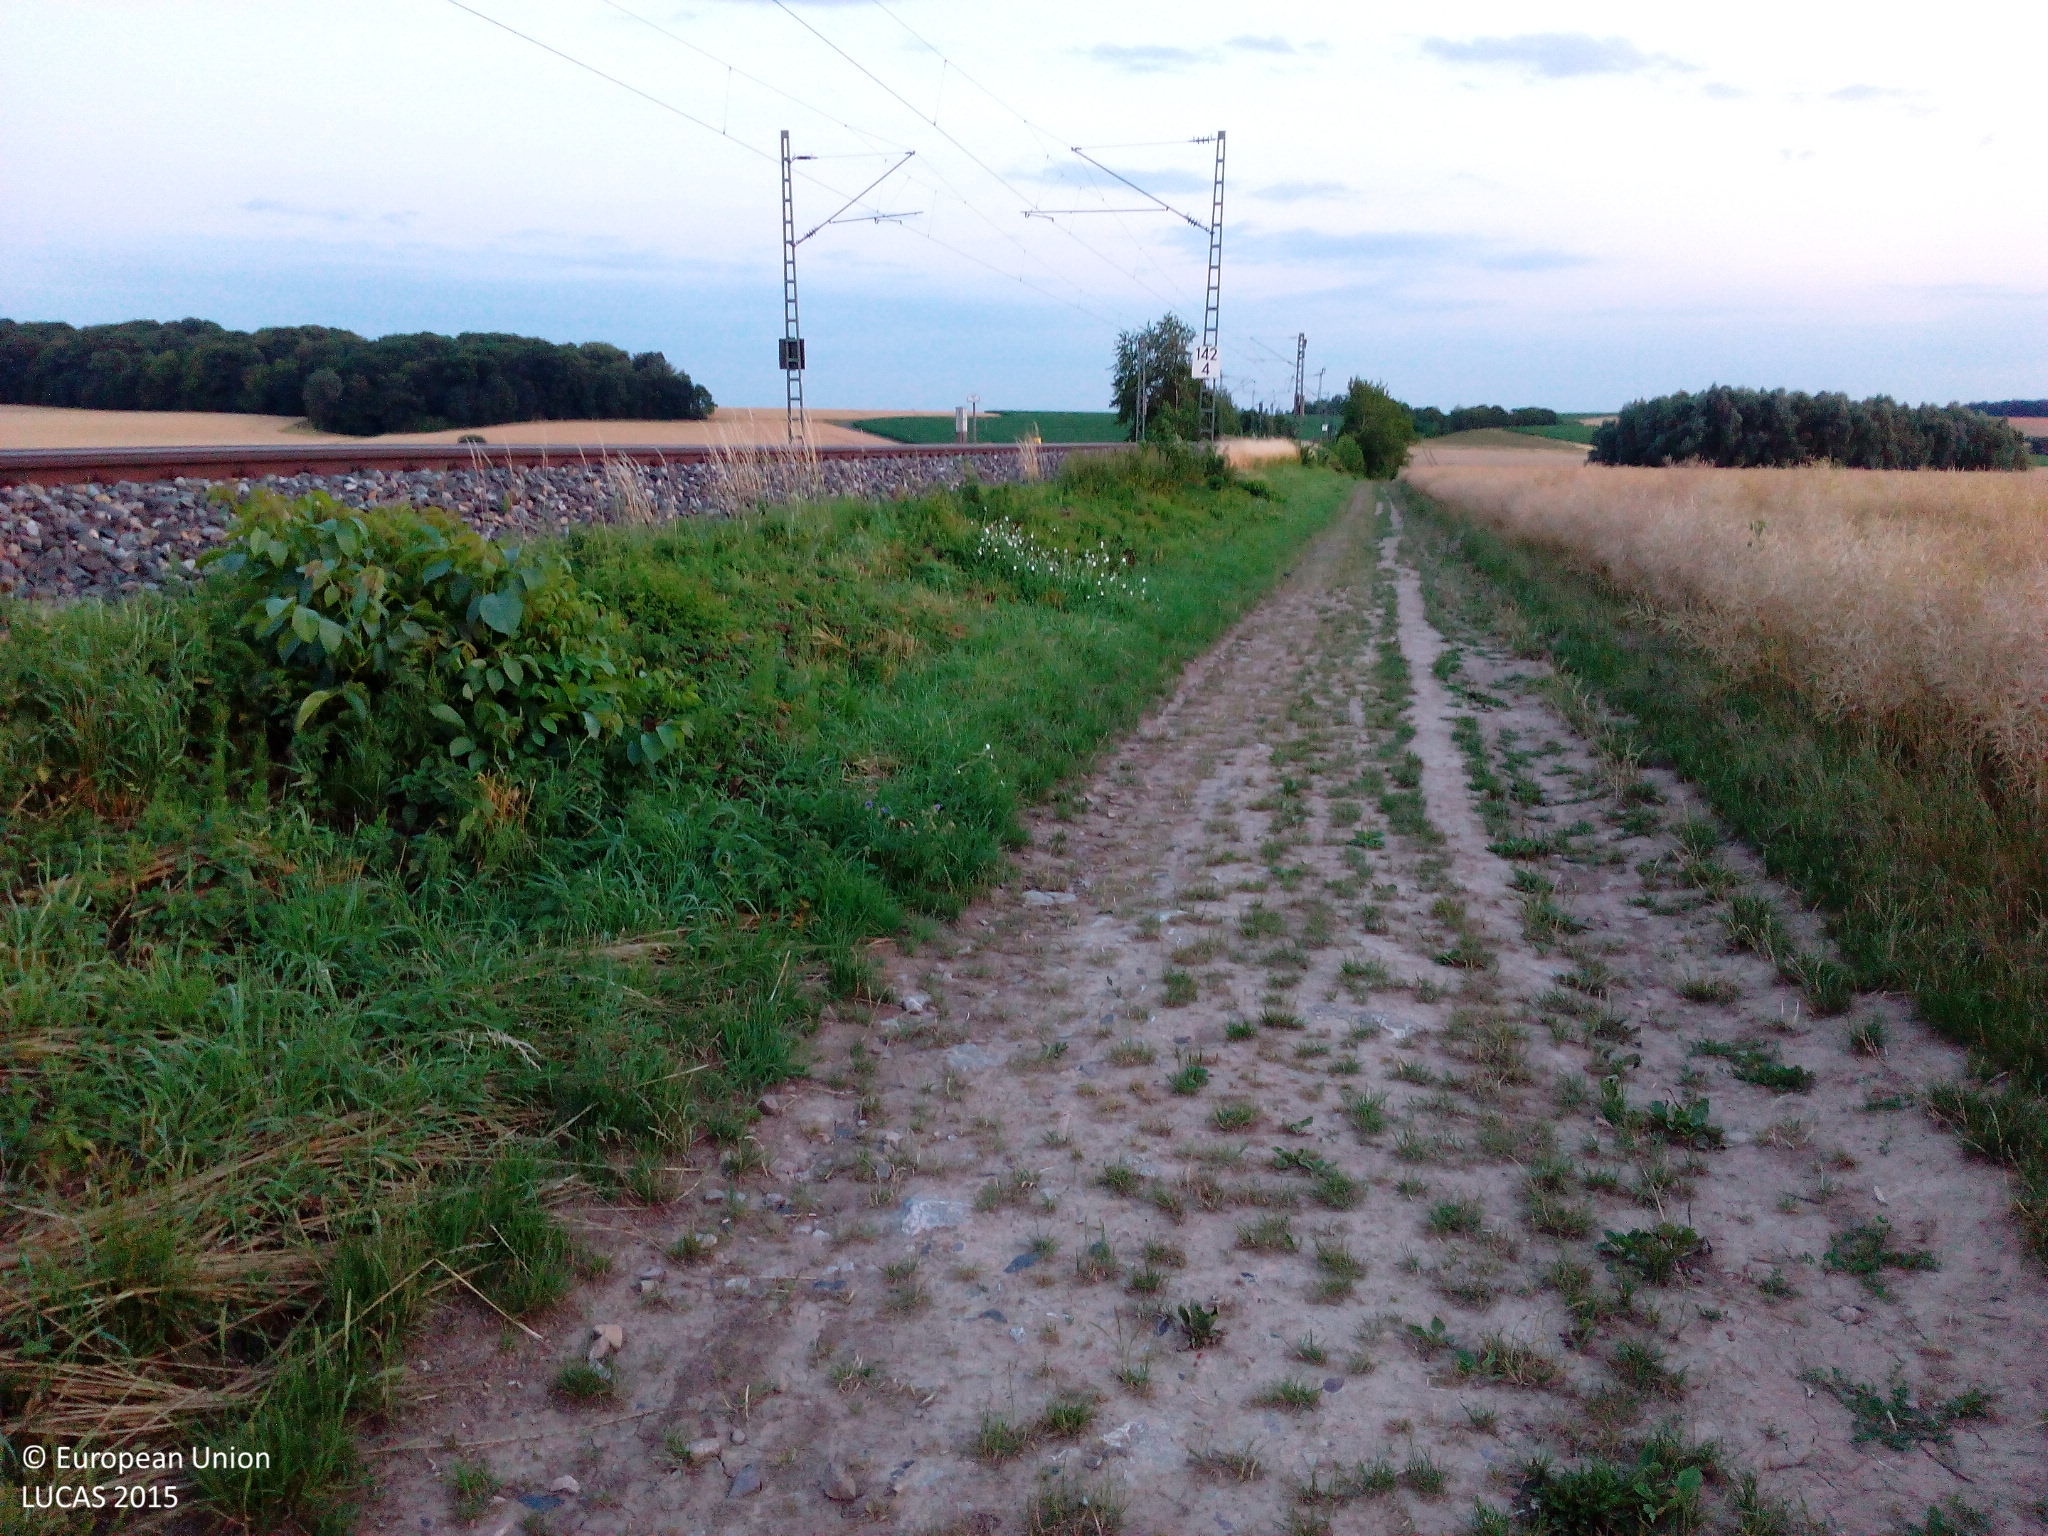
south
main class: Cropland
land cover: Rape and turnip rape
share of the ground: > 75 %
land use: Agriculture (excluding fallow land and kitchen gardens)
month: July
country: DE
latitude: 49.6806
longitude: 9.9030
